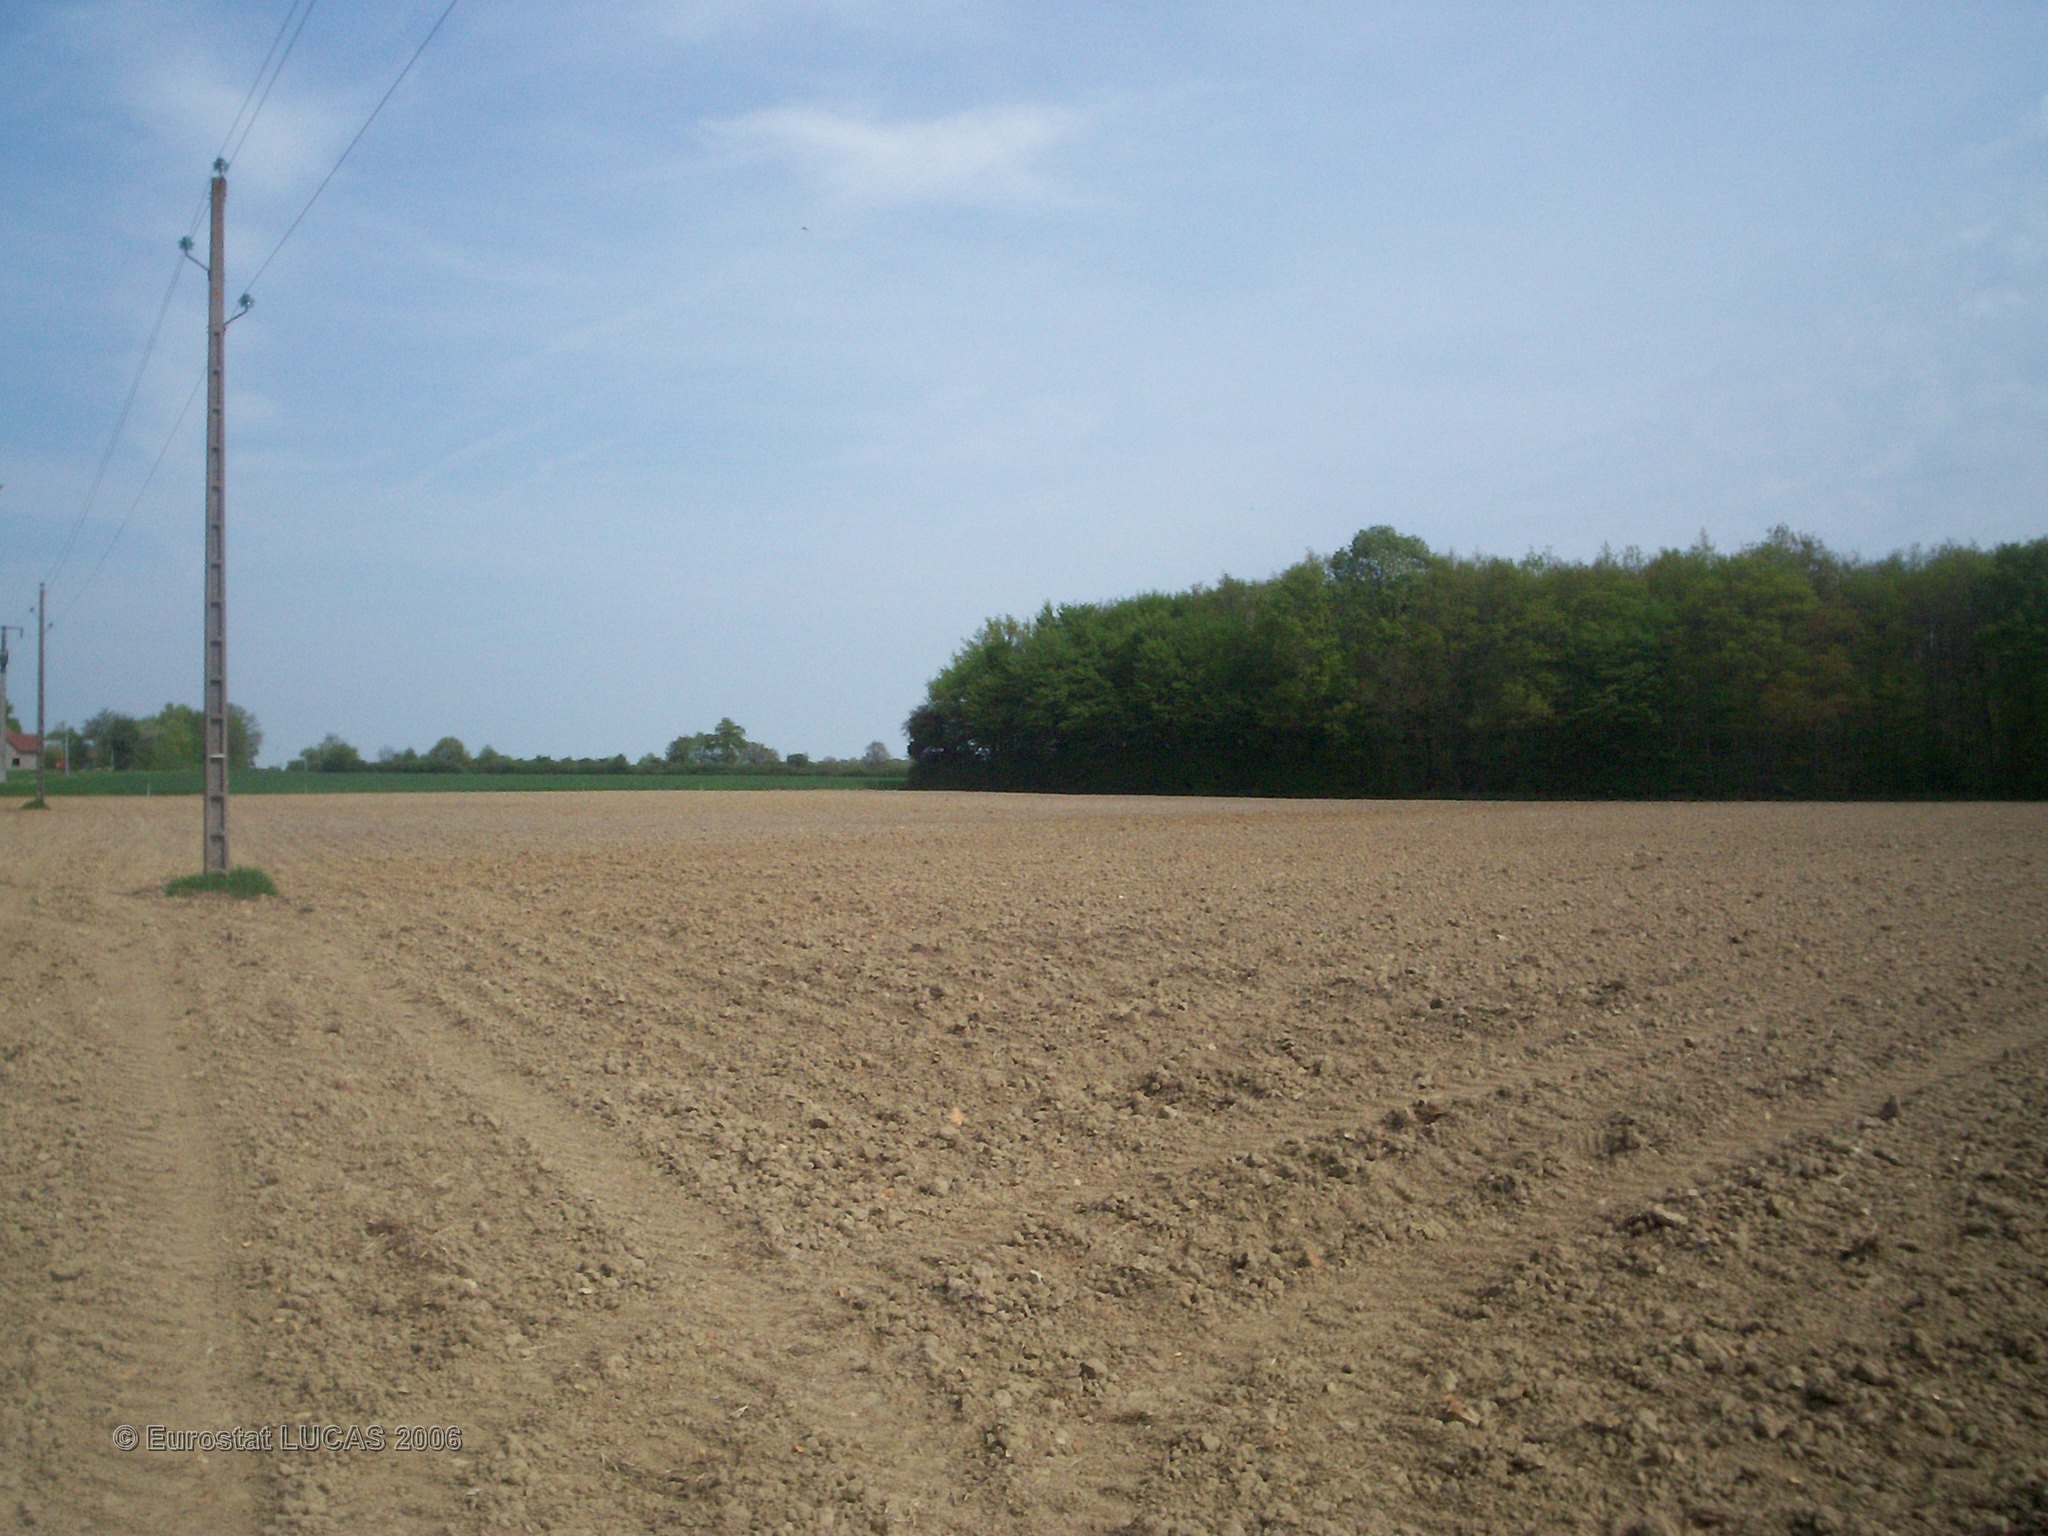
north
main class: Cropland
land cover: Maize
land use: Agriculture (excluding fallow land and kitchen gardens)
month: June
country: FR
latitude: 47.5991
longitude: 2.9313
